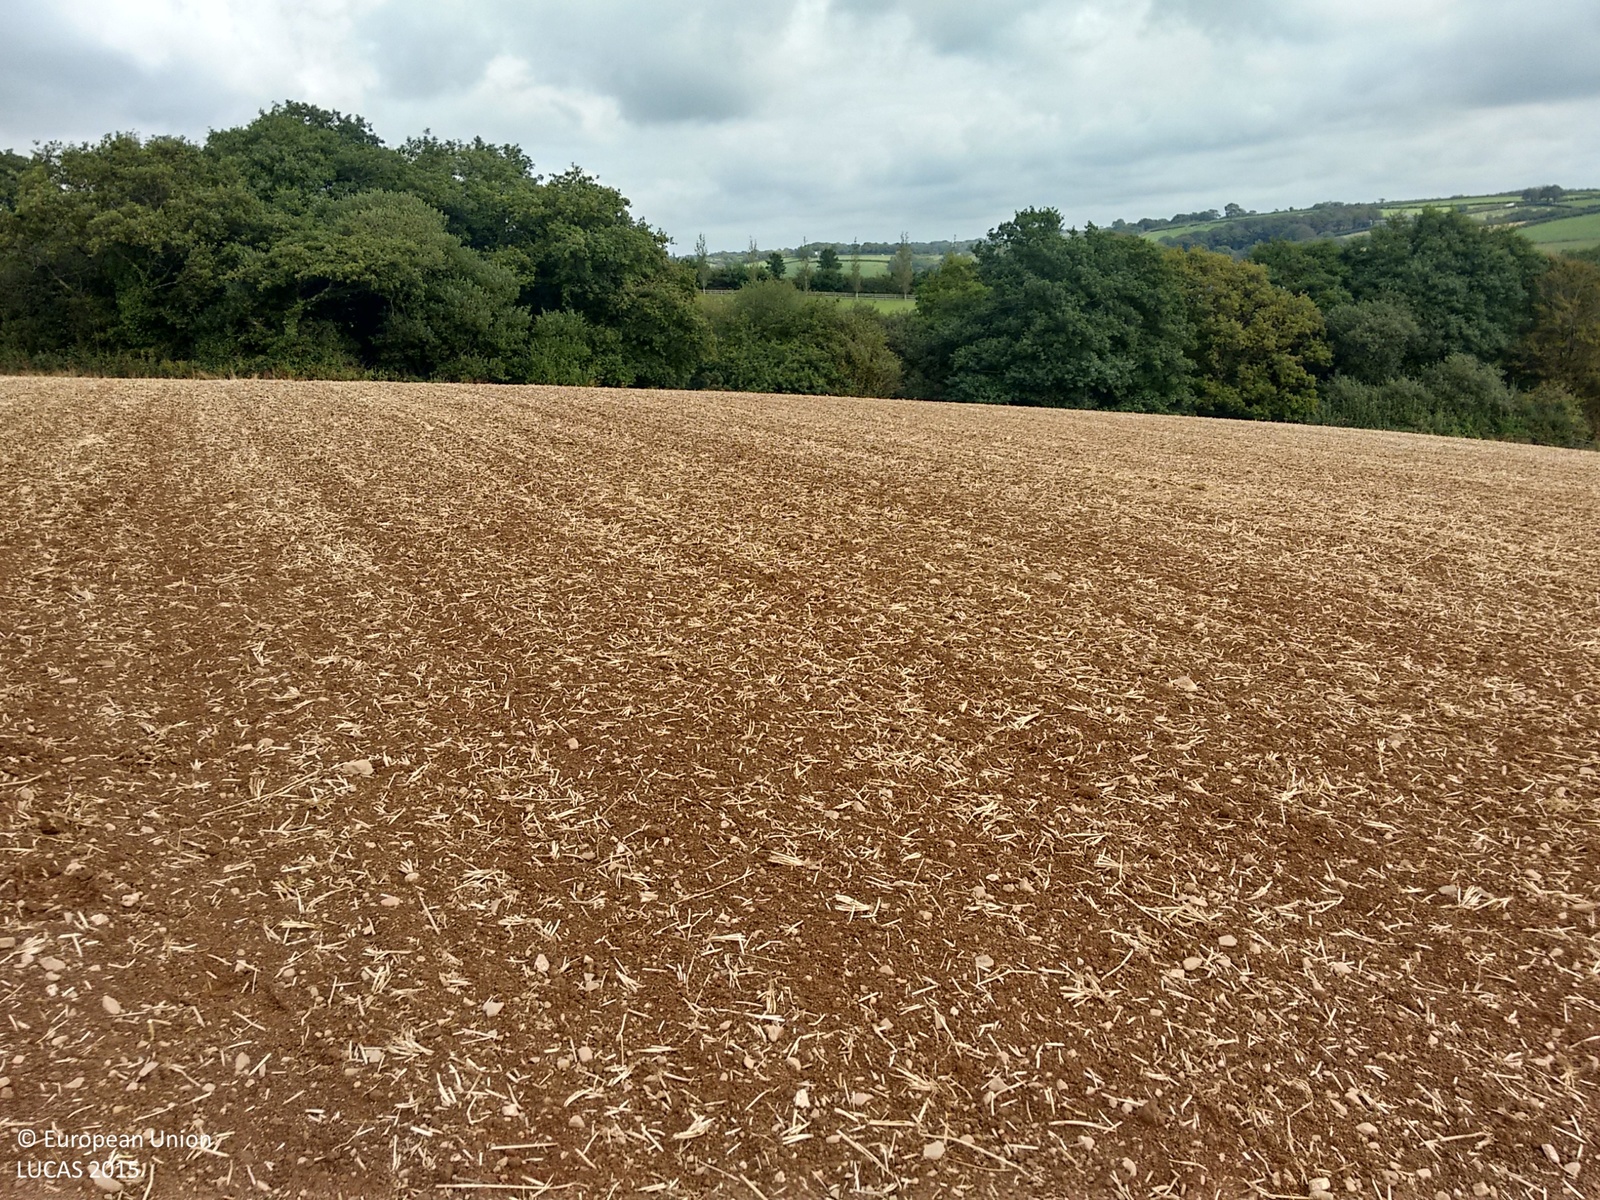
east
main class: Cropland
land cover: Barley
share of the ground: 10 - 25 %
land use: Agriculture (excluding fallow land and kitchen gardens)
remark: Harvested field
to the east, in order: Barley; Broadleaved woodland; Rivers and streams; Broadleaved woodland; Fences; Grassland without tree/shrub cover; Lines of trees; Fences; Grass margins; Paved roads, cycling and walking lanes; Grass margins; Managed hedges; Electric lines; Fences; Grassland without tree/shrub cover
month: September
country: GB
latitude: 50.7683
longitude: -4.3514
